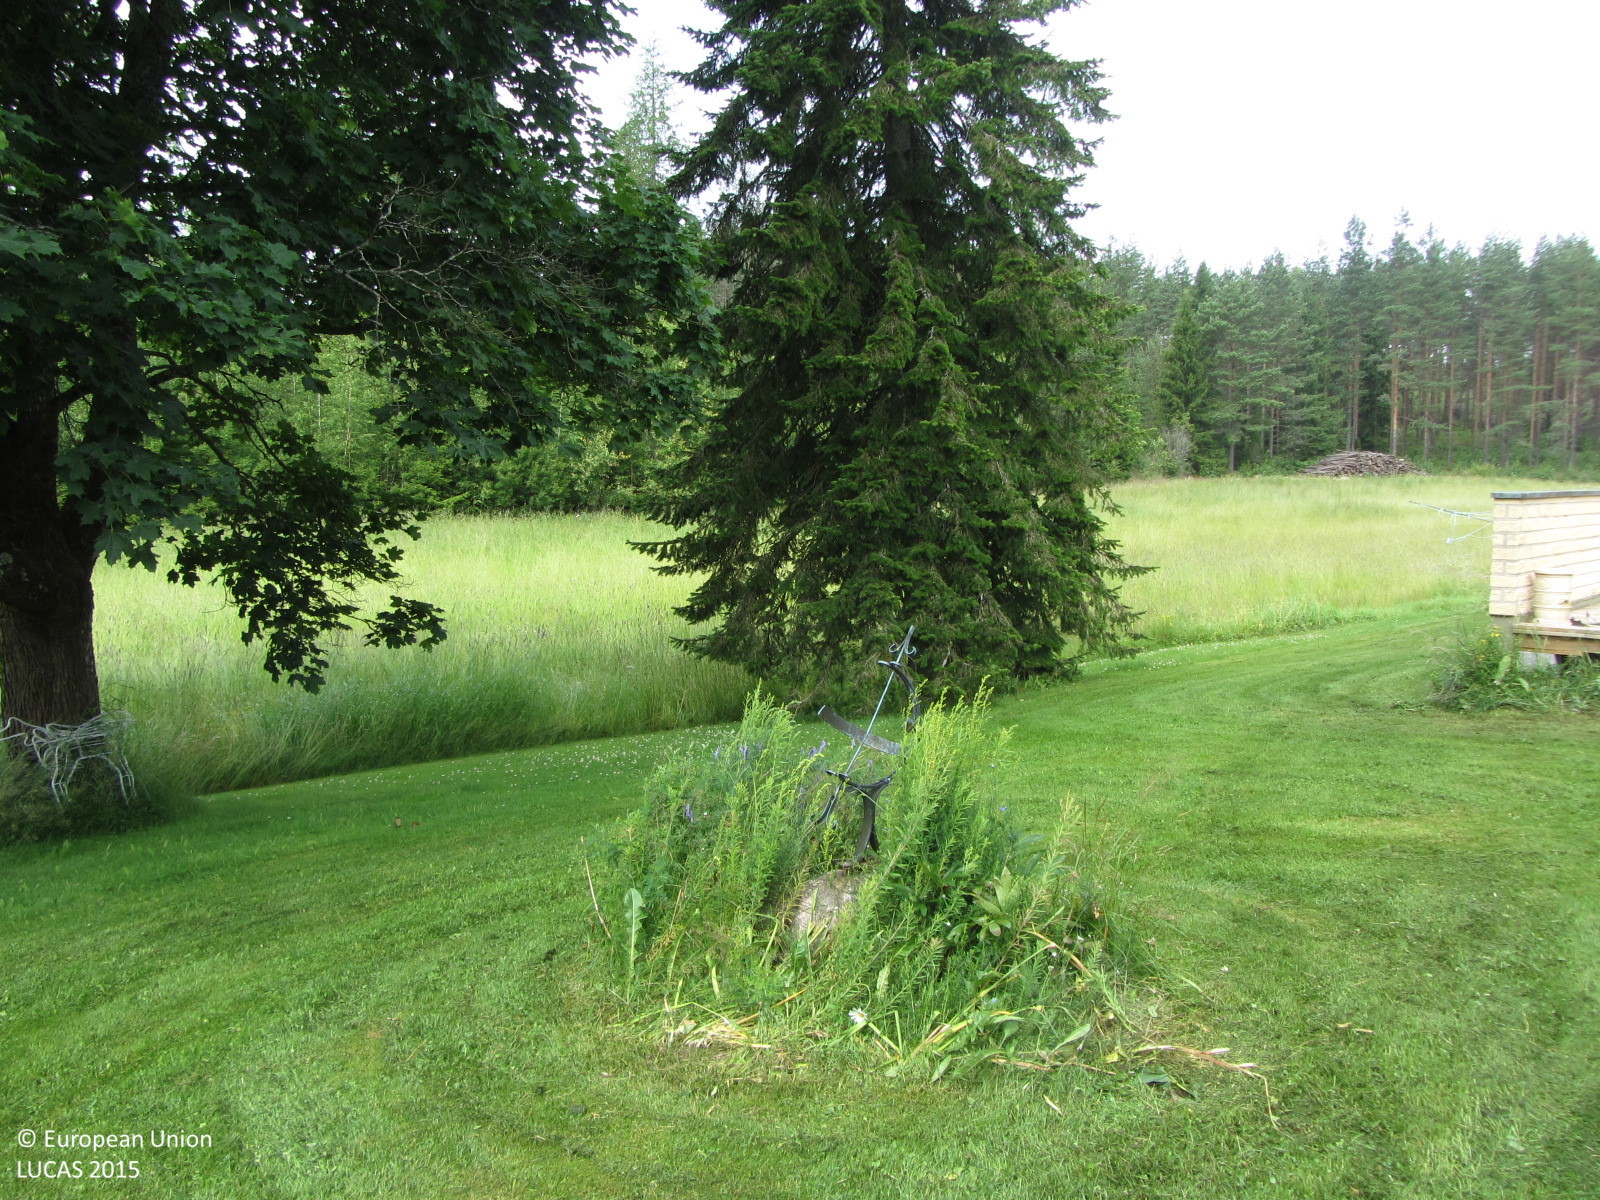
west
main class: Grassland
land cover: Grassland with sparse tree/shrub cover
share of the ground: > 75 %
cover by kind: herbaceous plants 85 %, shrubs 10 %, broadleaved forest trees 5 %
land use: Residential
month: July
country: FI
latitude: 60.0724
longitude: 24.0992
